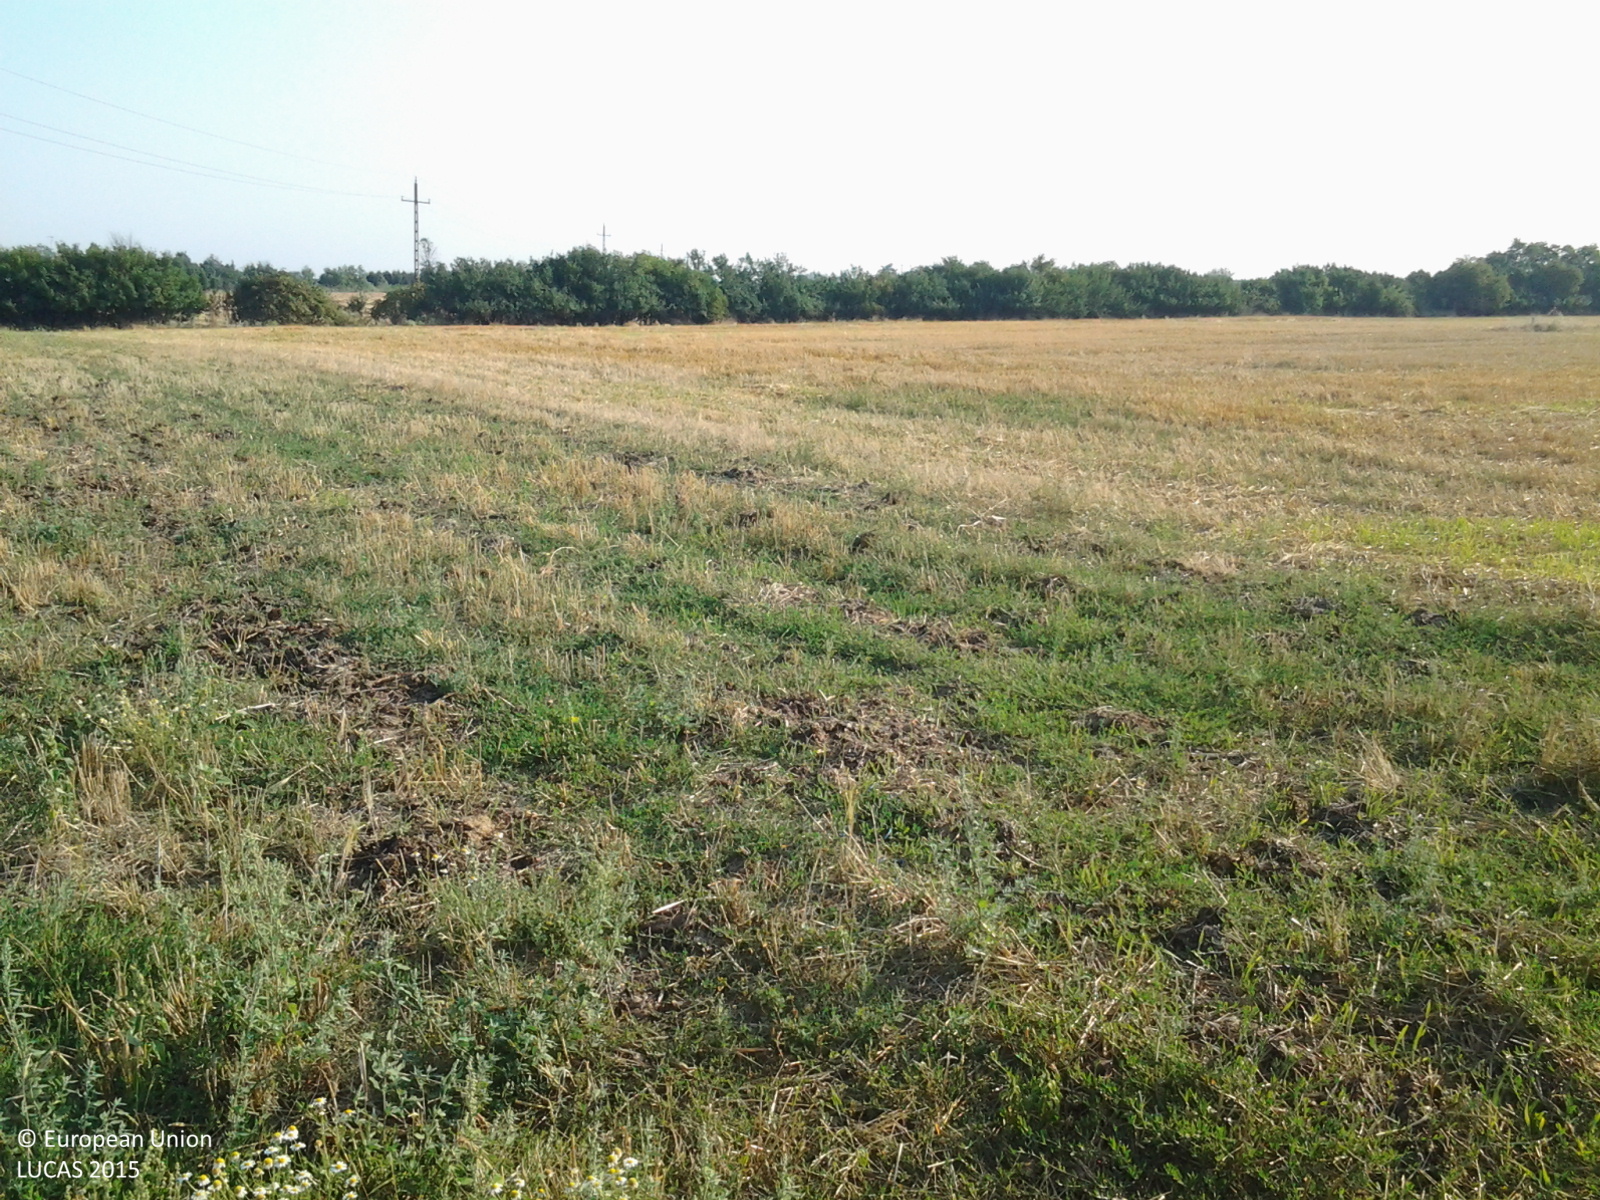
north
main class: Cropland
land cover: Common wheat
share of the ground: > 75 %
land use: Agriculture (excluding fallow land and kitchen gardens)
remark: Harvested field
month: July
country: HU
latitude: 46.9862
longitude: 20.5874
